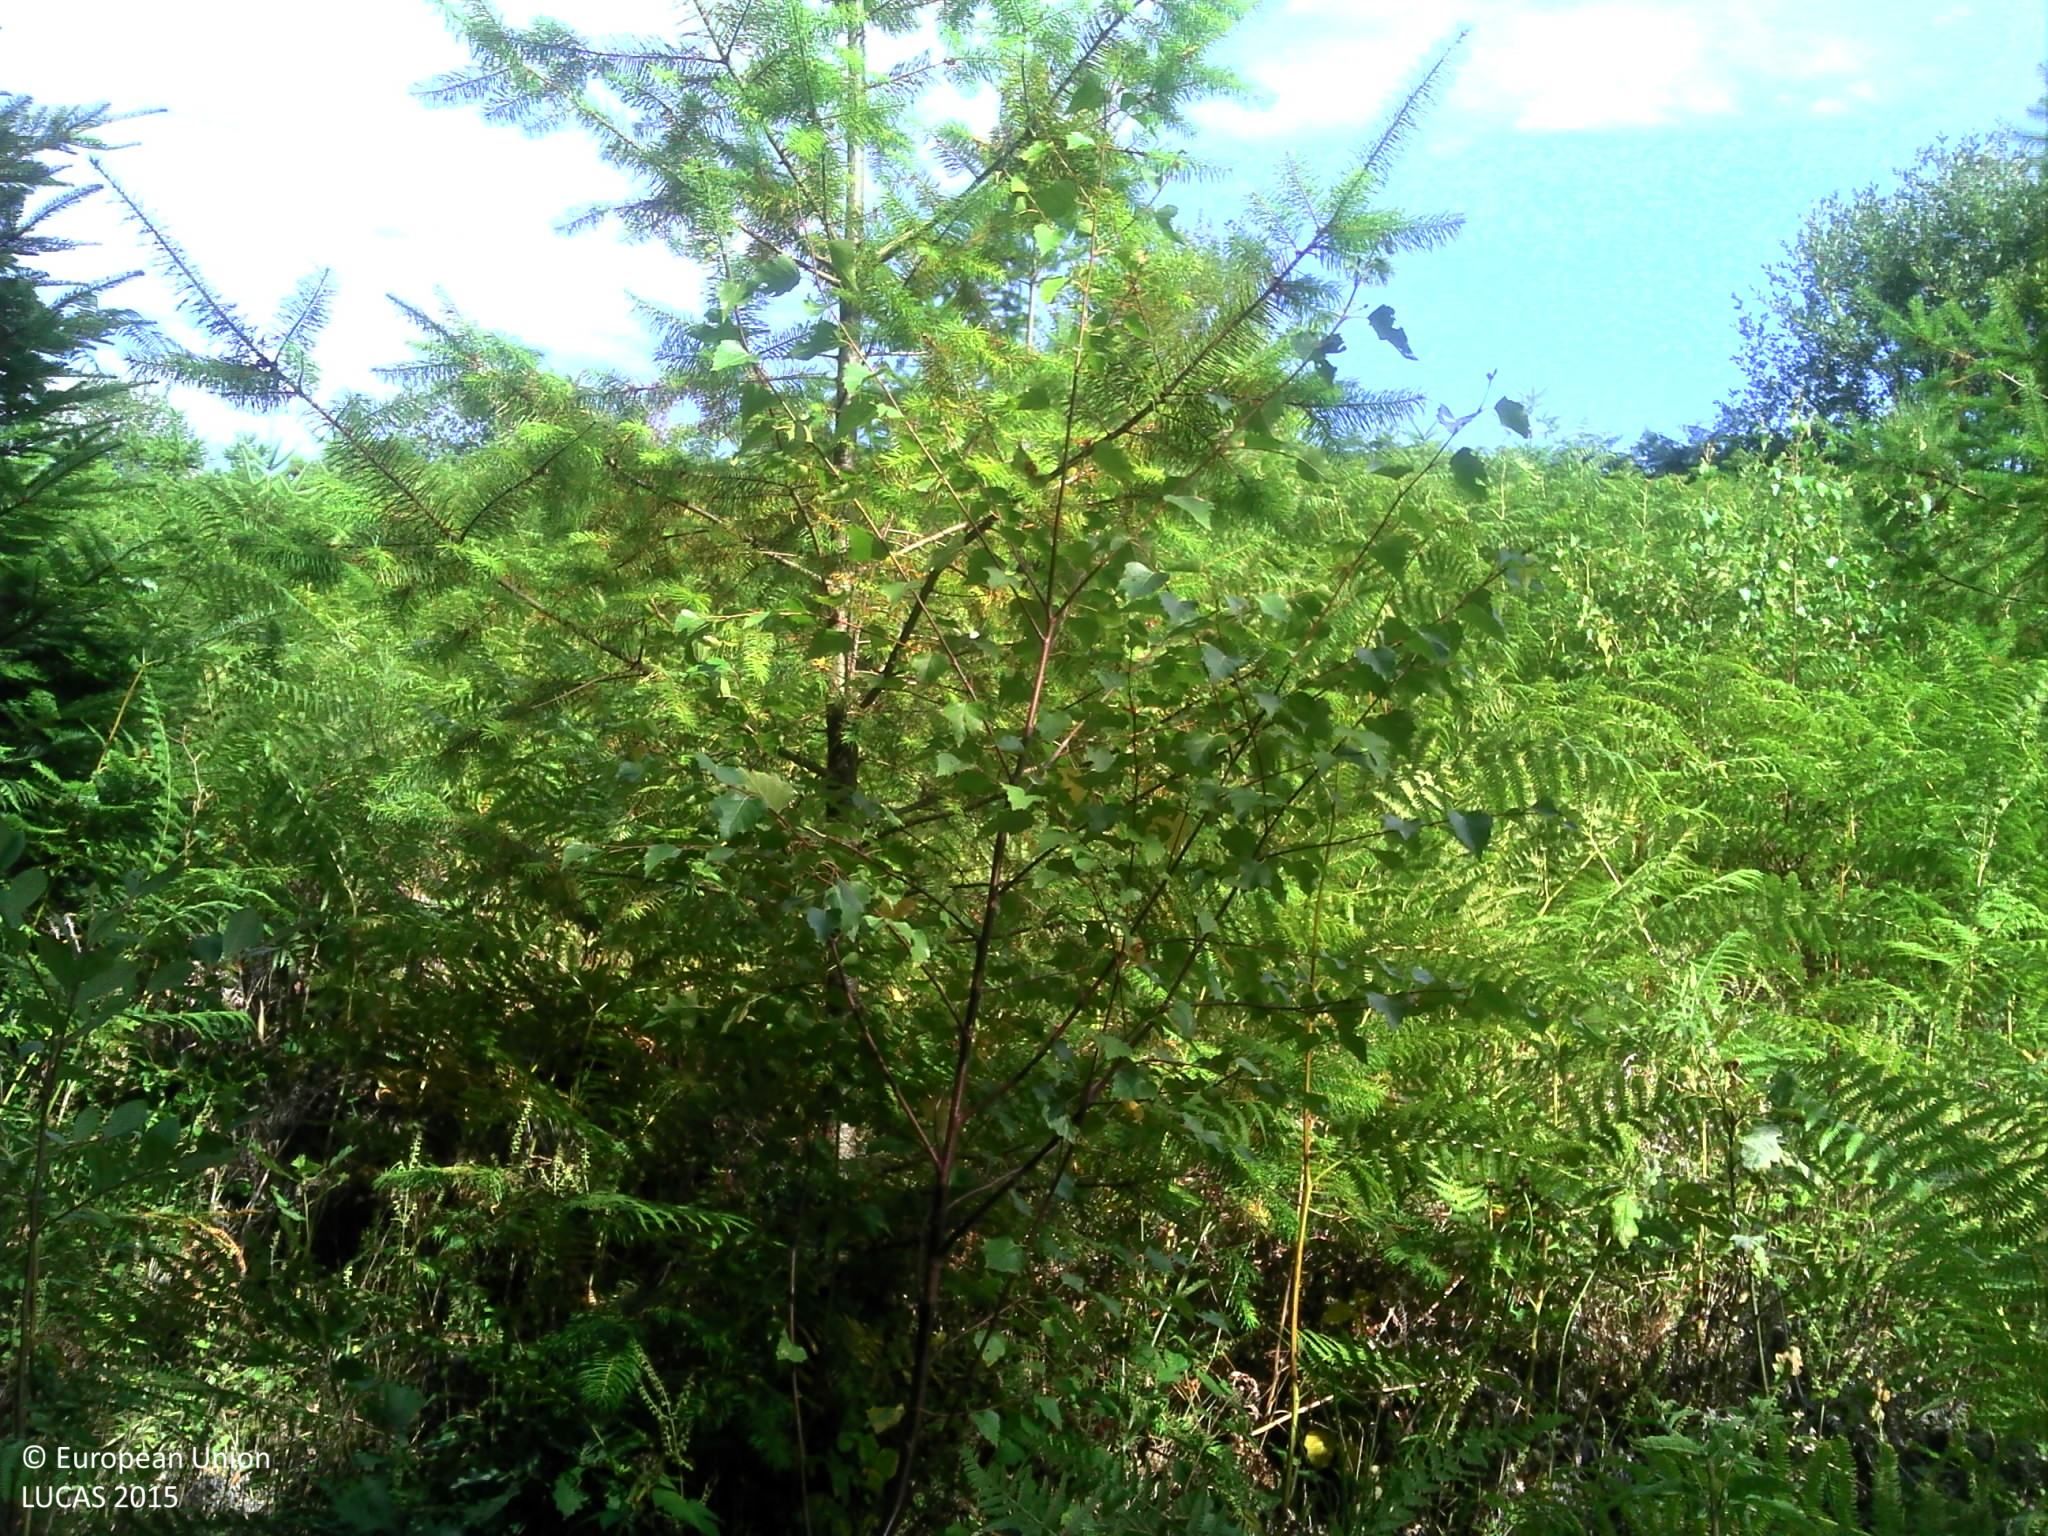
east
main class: Grassland
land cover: Spontaneously vegetated surfaces
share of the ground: > 75 %
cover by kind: herbaceous plants 95 %, shrubs 5 %
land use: Abandoned areas
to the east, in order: Spontaneously vegetated surfaces; Pine dominated coniferous woodland; Paved roads, cycling and walking lanes; Spontaneously vegetated surfaces; Pine dominated coniferous woodland
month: July
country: FR
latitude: 45.6753
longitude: 1.8171
